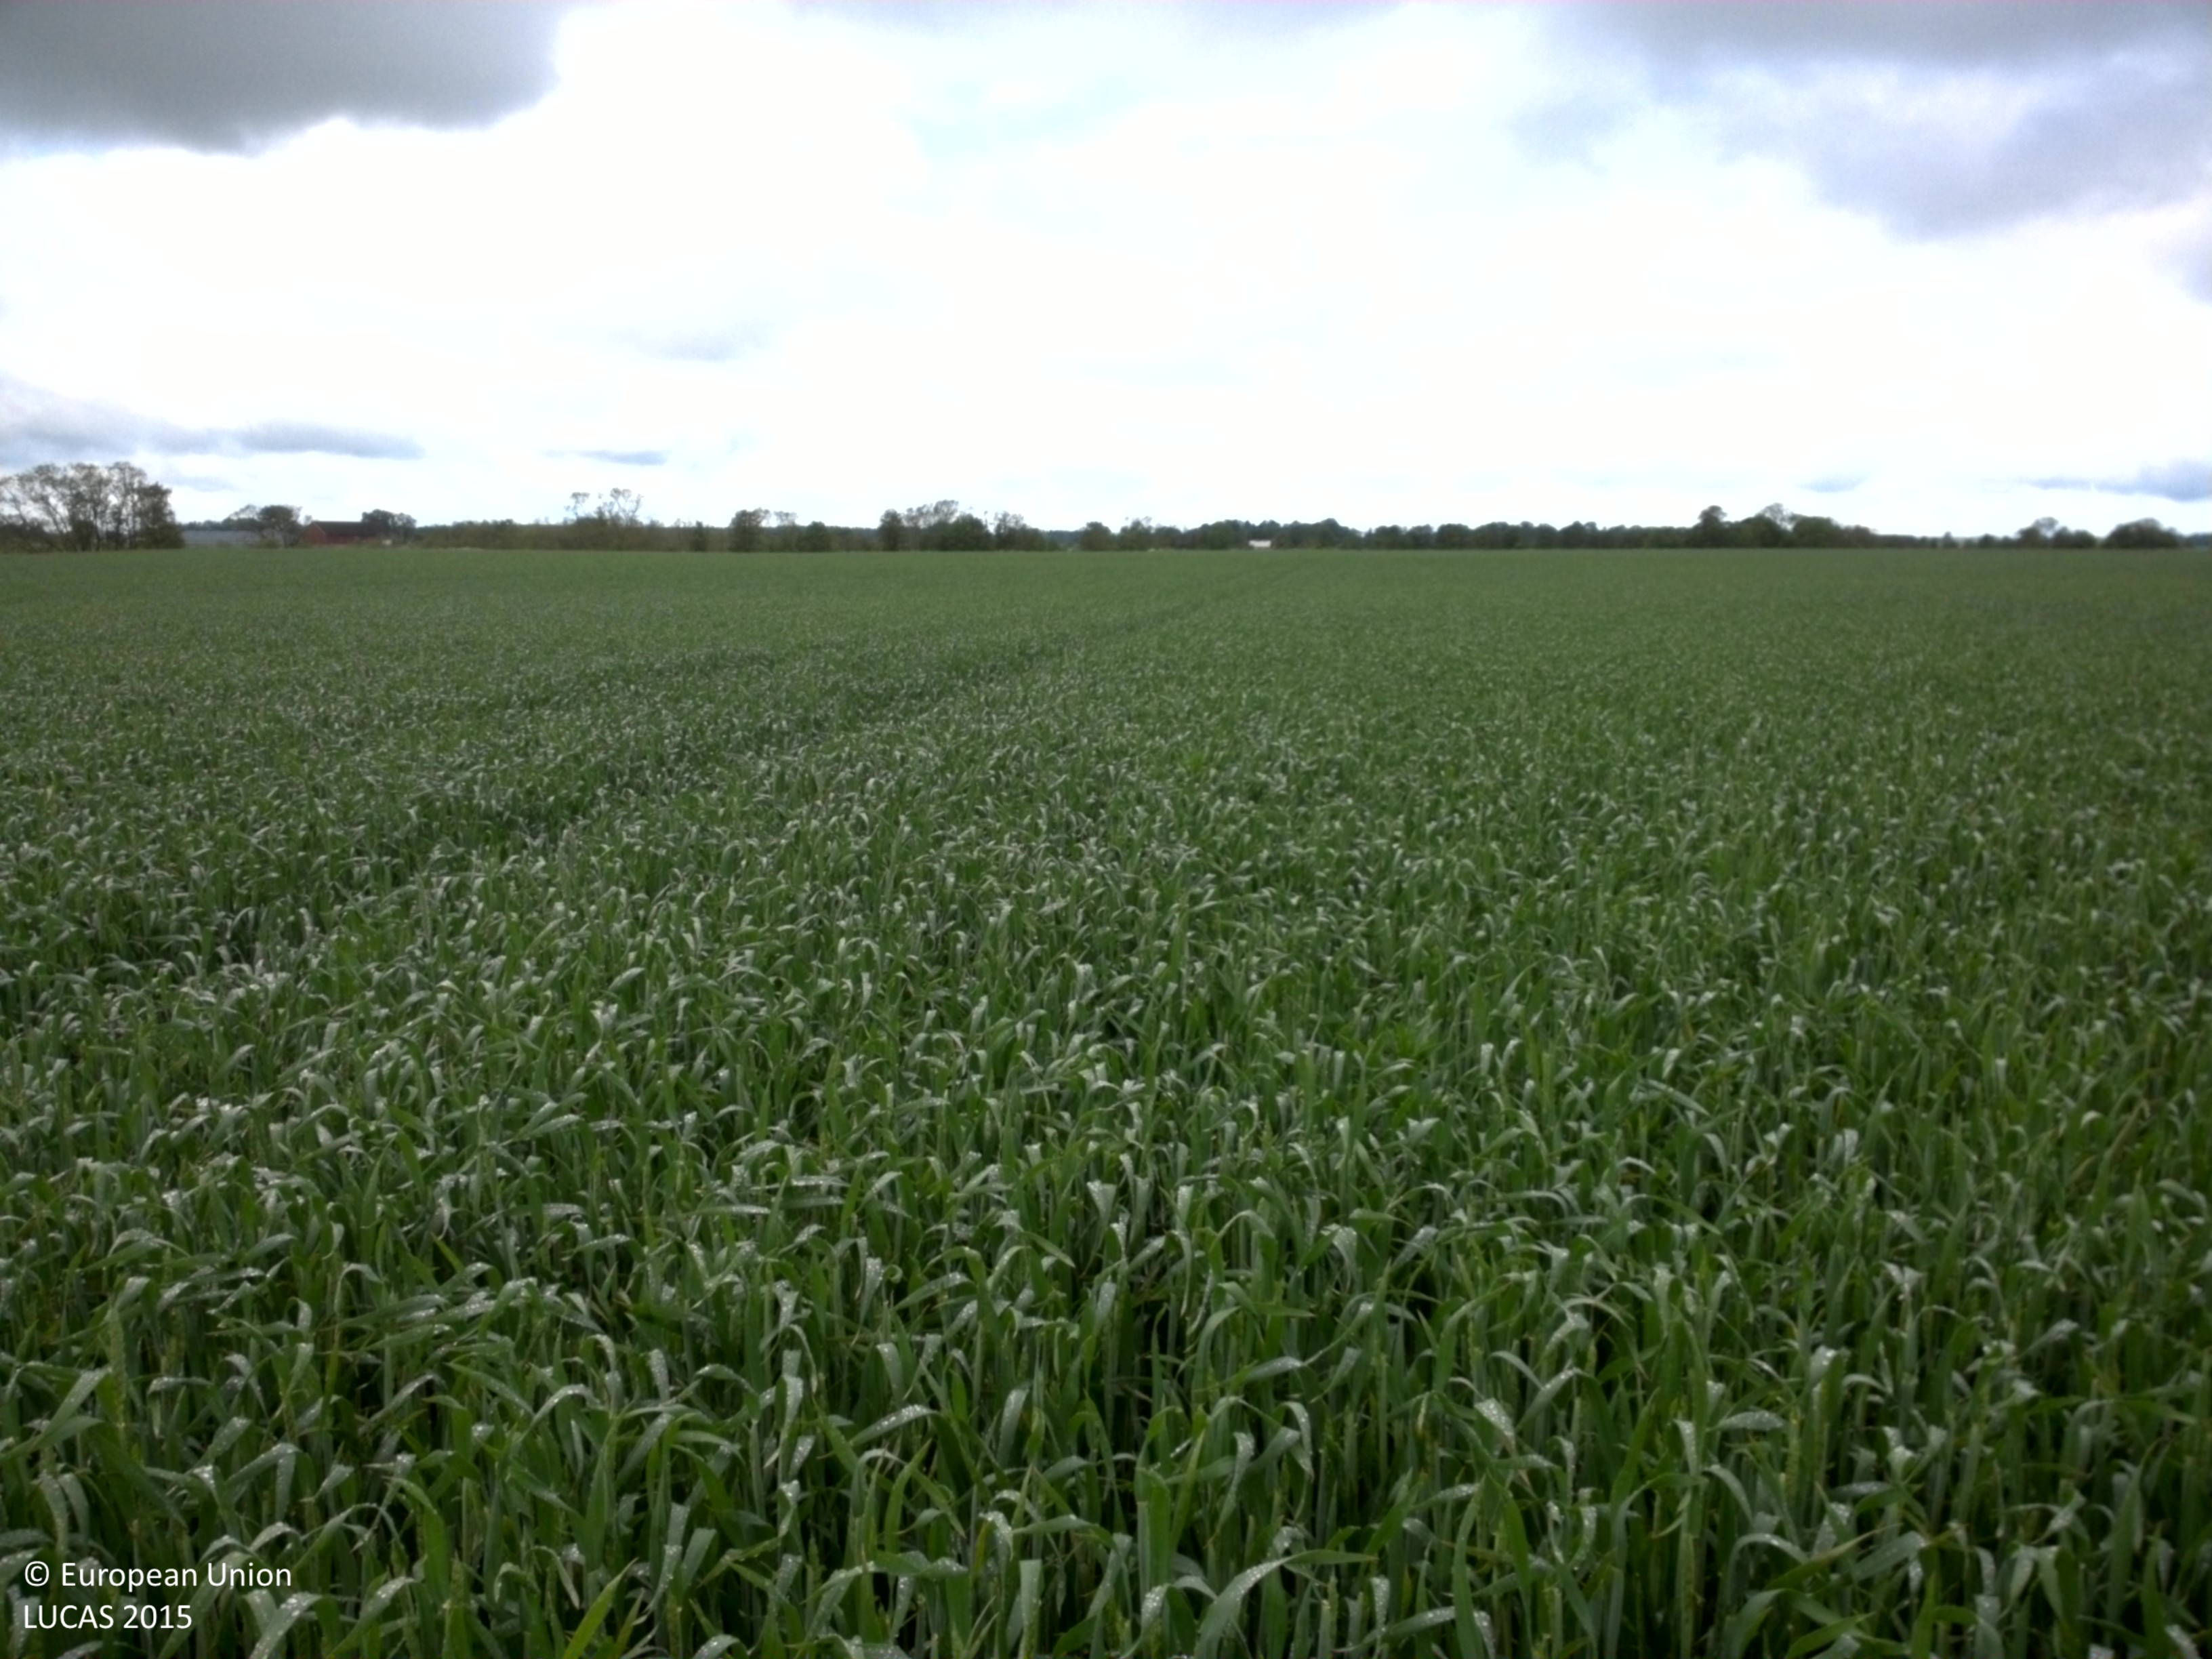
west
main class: Cropland
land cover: Common wheat
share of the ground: > 75 %
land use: Agriculture (excluding fallow land and kitchen gardens)
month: June
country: SE
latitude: 58.4401
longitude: 15.2873
